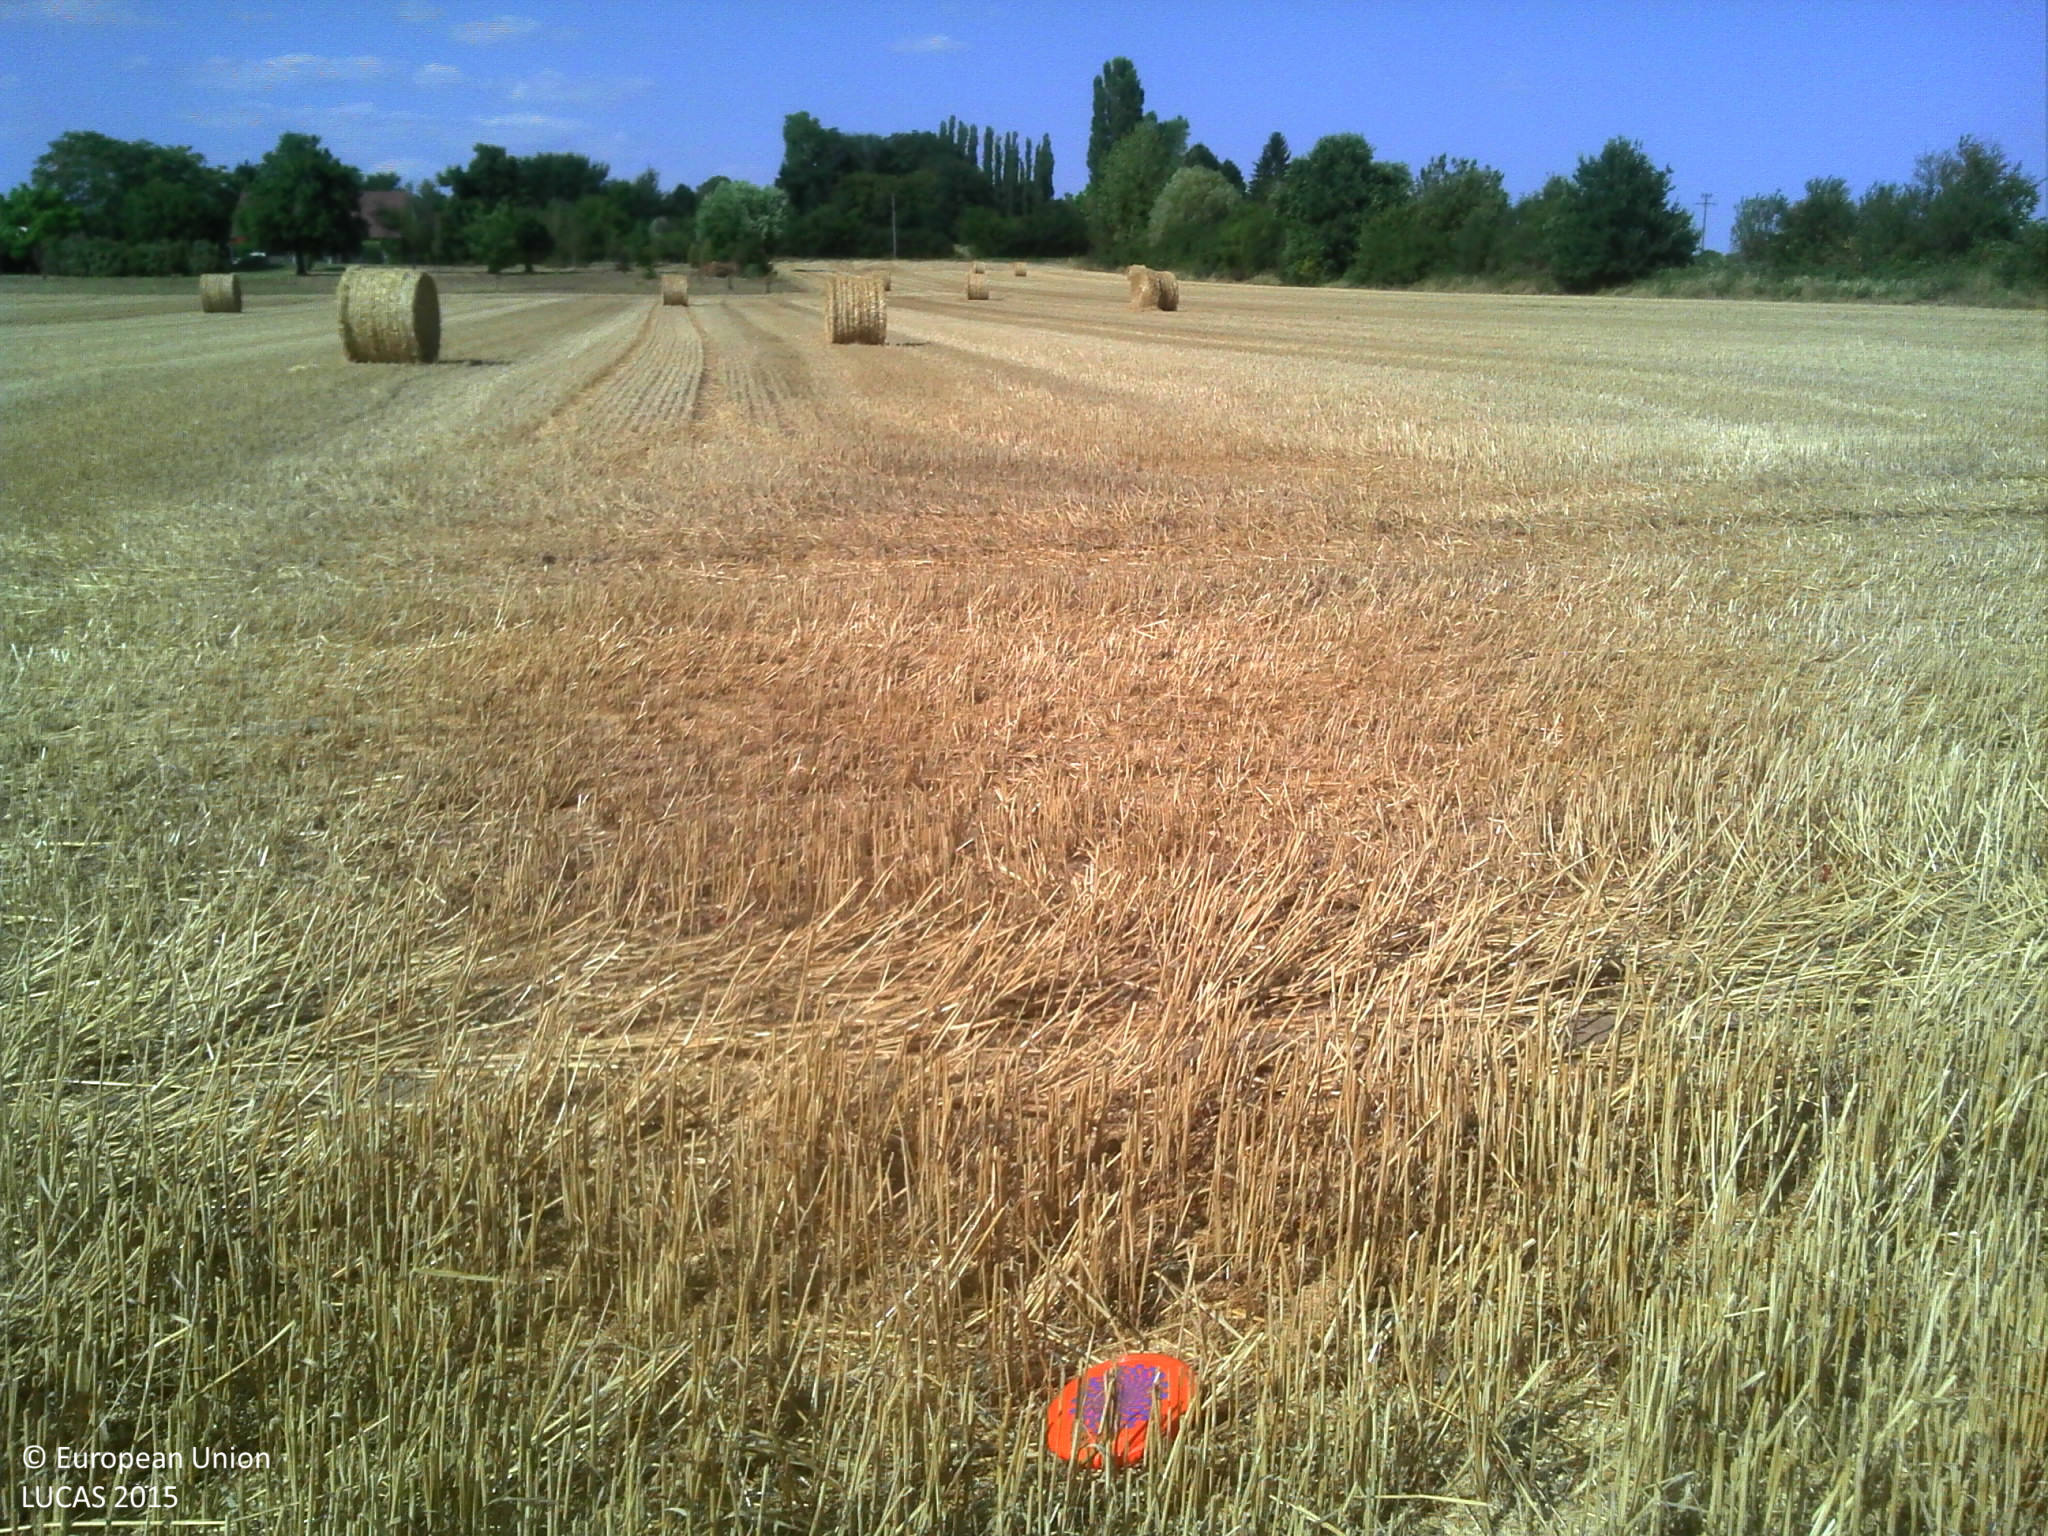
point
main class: Cropland
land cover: Common wheat
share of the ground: > 75 %
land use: Agriculture (excluding fallow land and kitchen gardens)
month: July
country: FR
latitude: 46.9031
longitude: 5.0260
